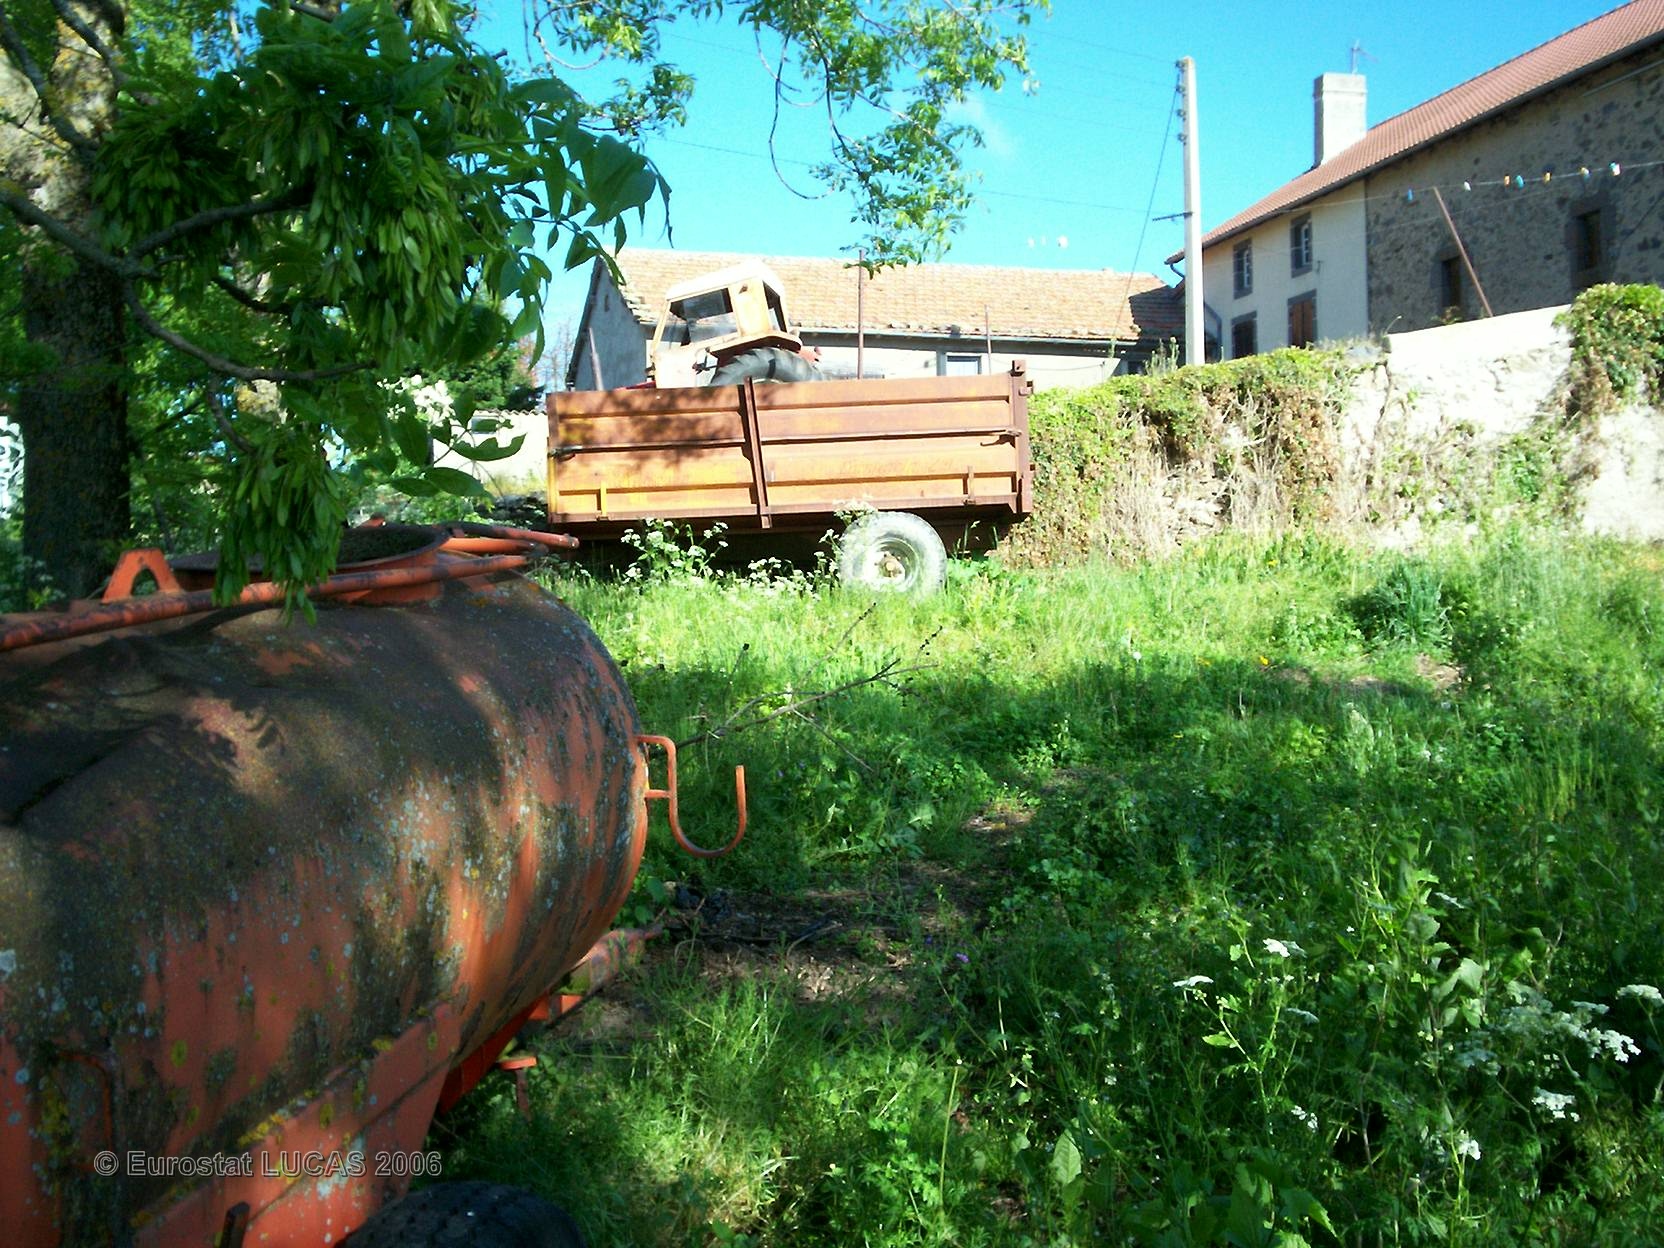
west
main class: Grassland
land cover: Grassland with sparse tree/shrub cover
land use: Agriculture (excluding fallow land and kitchen gardens)
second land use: Residential
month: June
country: FR
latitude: 45.1436
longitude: 3.2493
